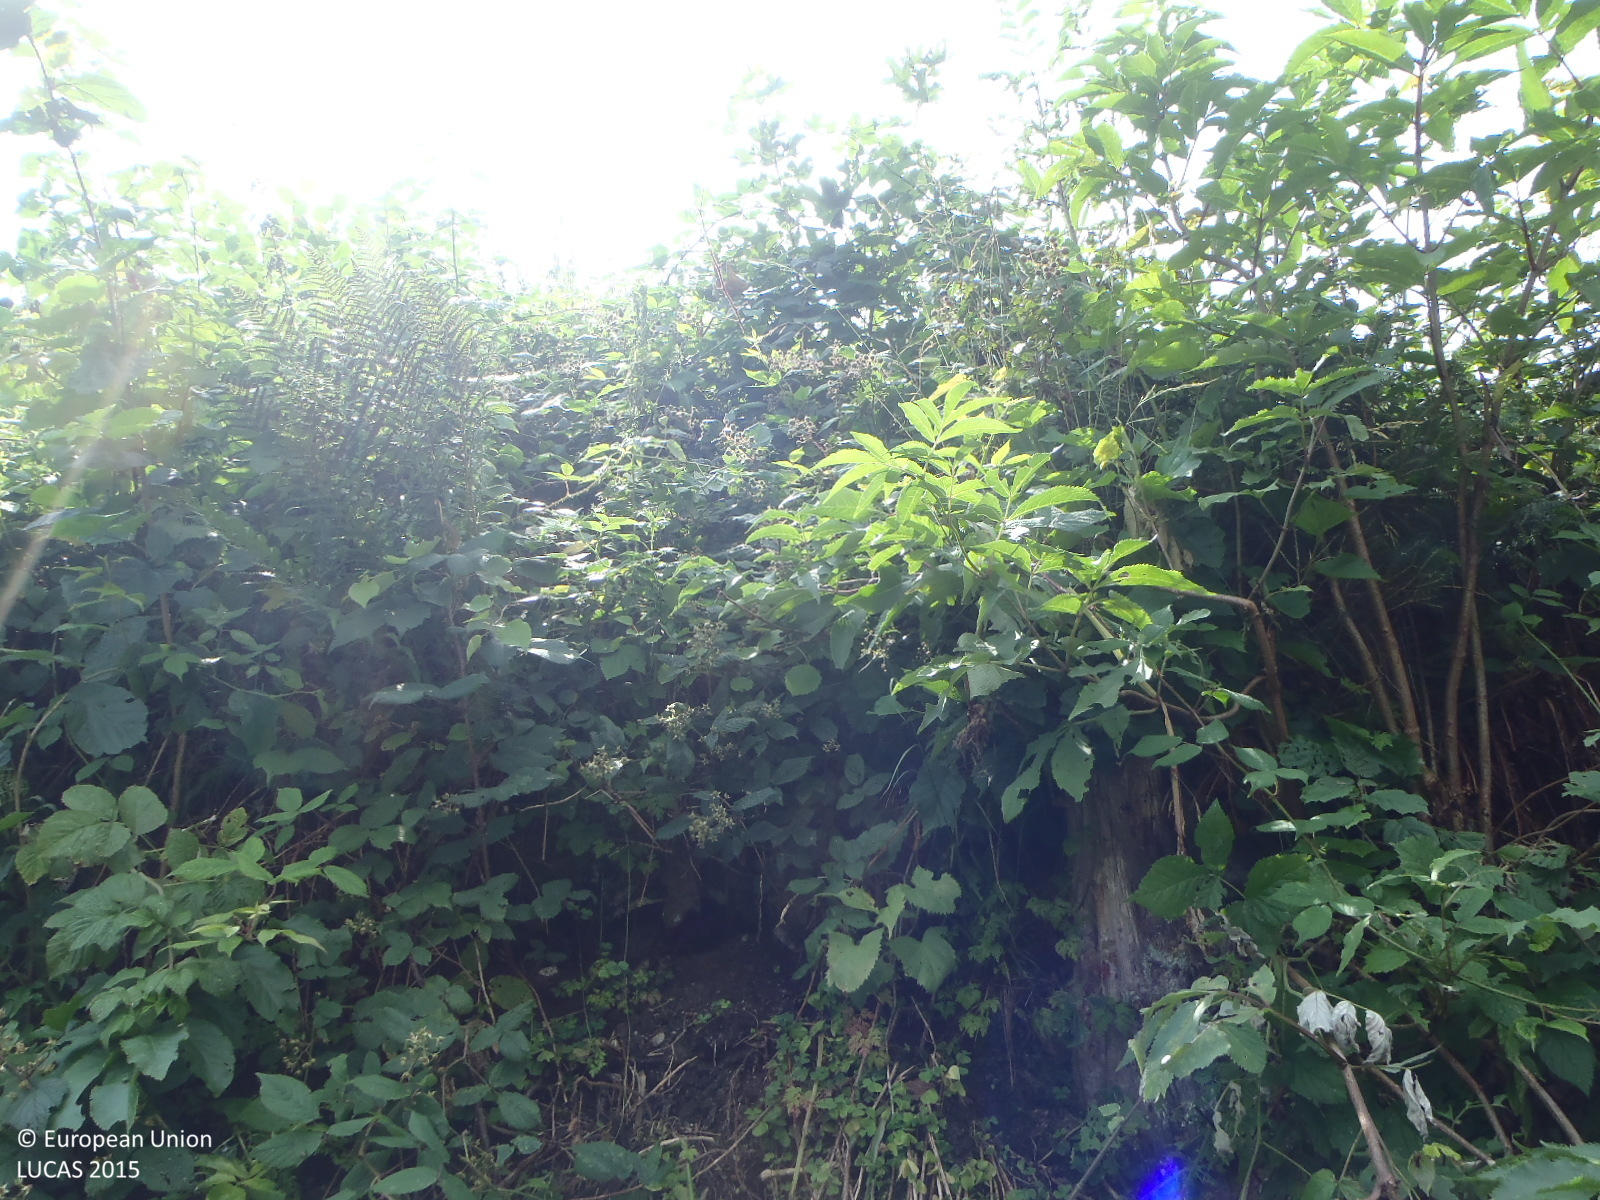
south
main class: Grassland
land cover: Grassland without tree/shrub cover
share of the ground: > 75 %
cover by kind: herbaceous plants 100 %
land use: Agriculture (excluding fallow land and kitchen gardens)
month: July
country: AT
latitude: 47.3261
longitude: 11.8377
